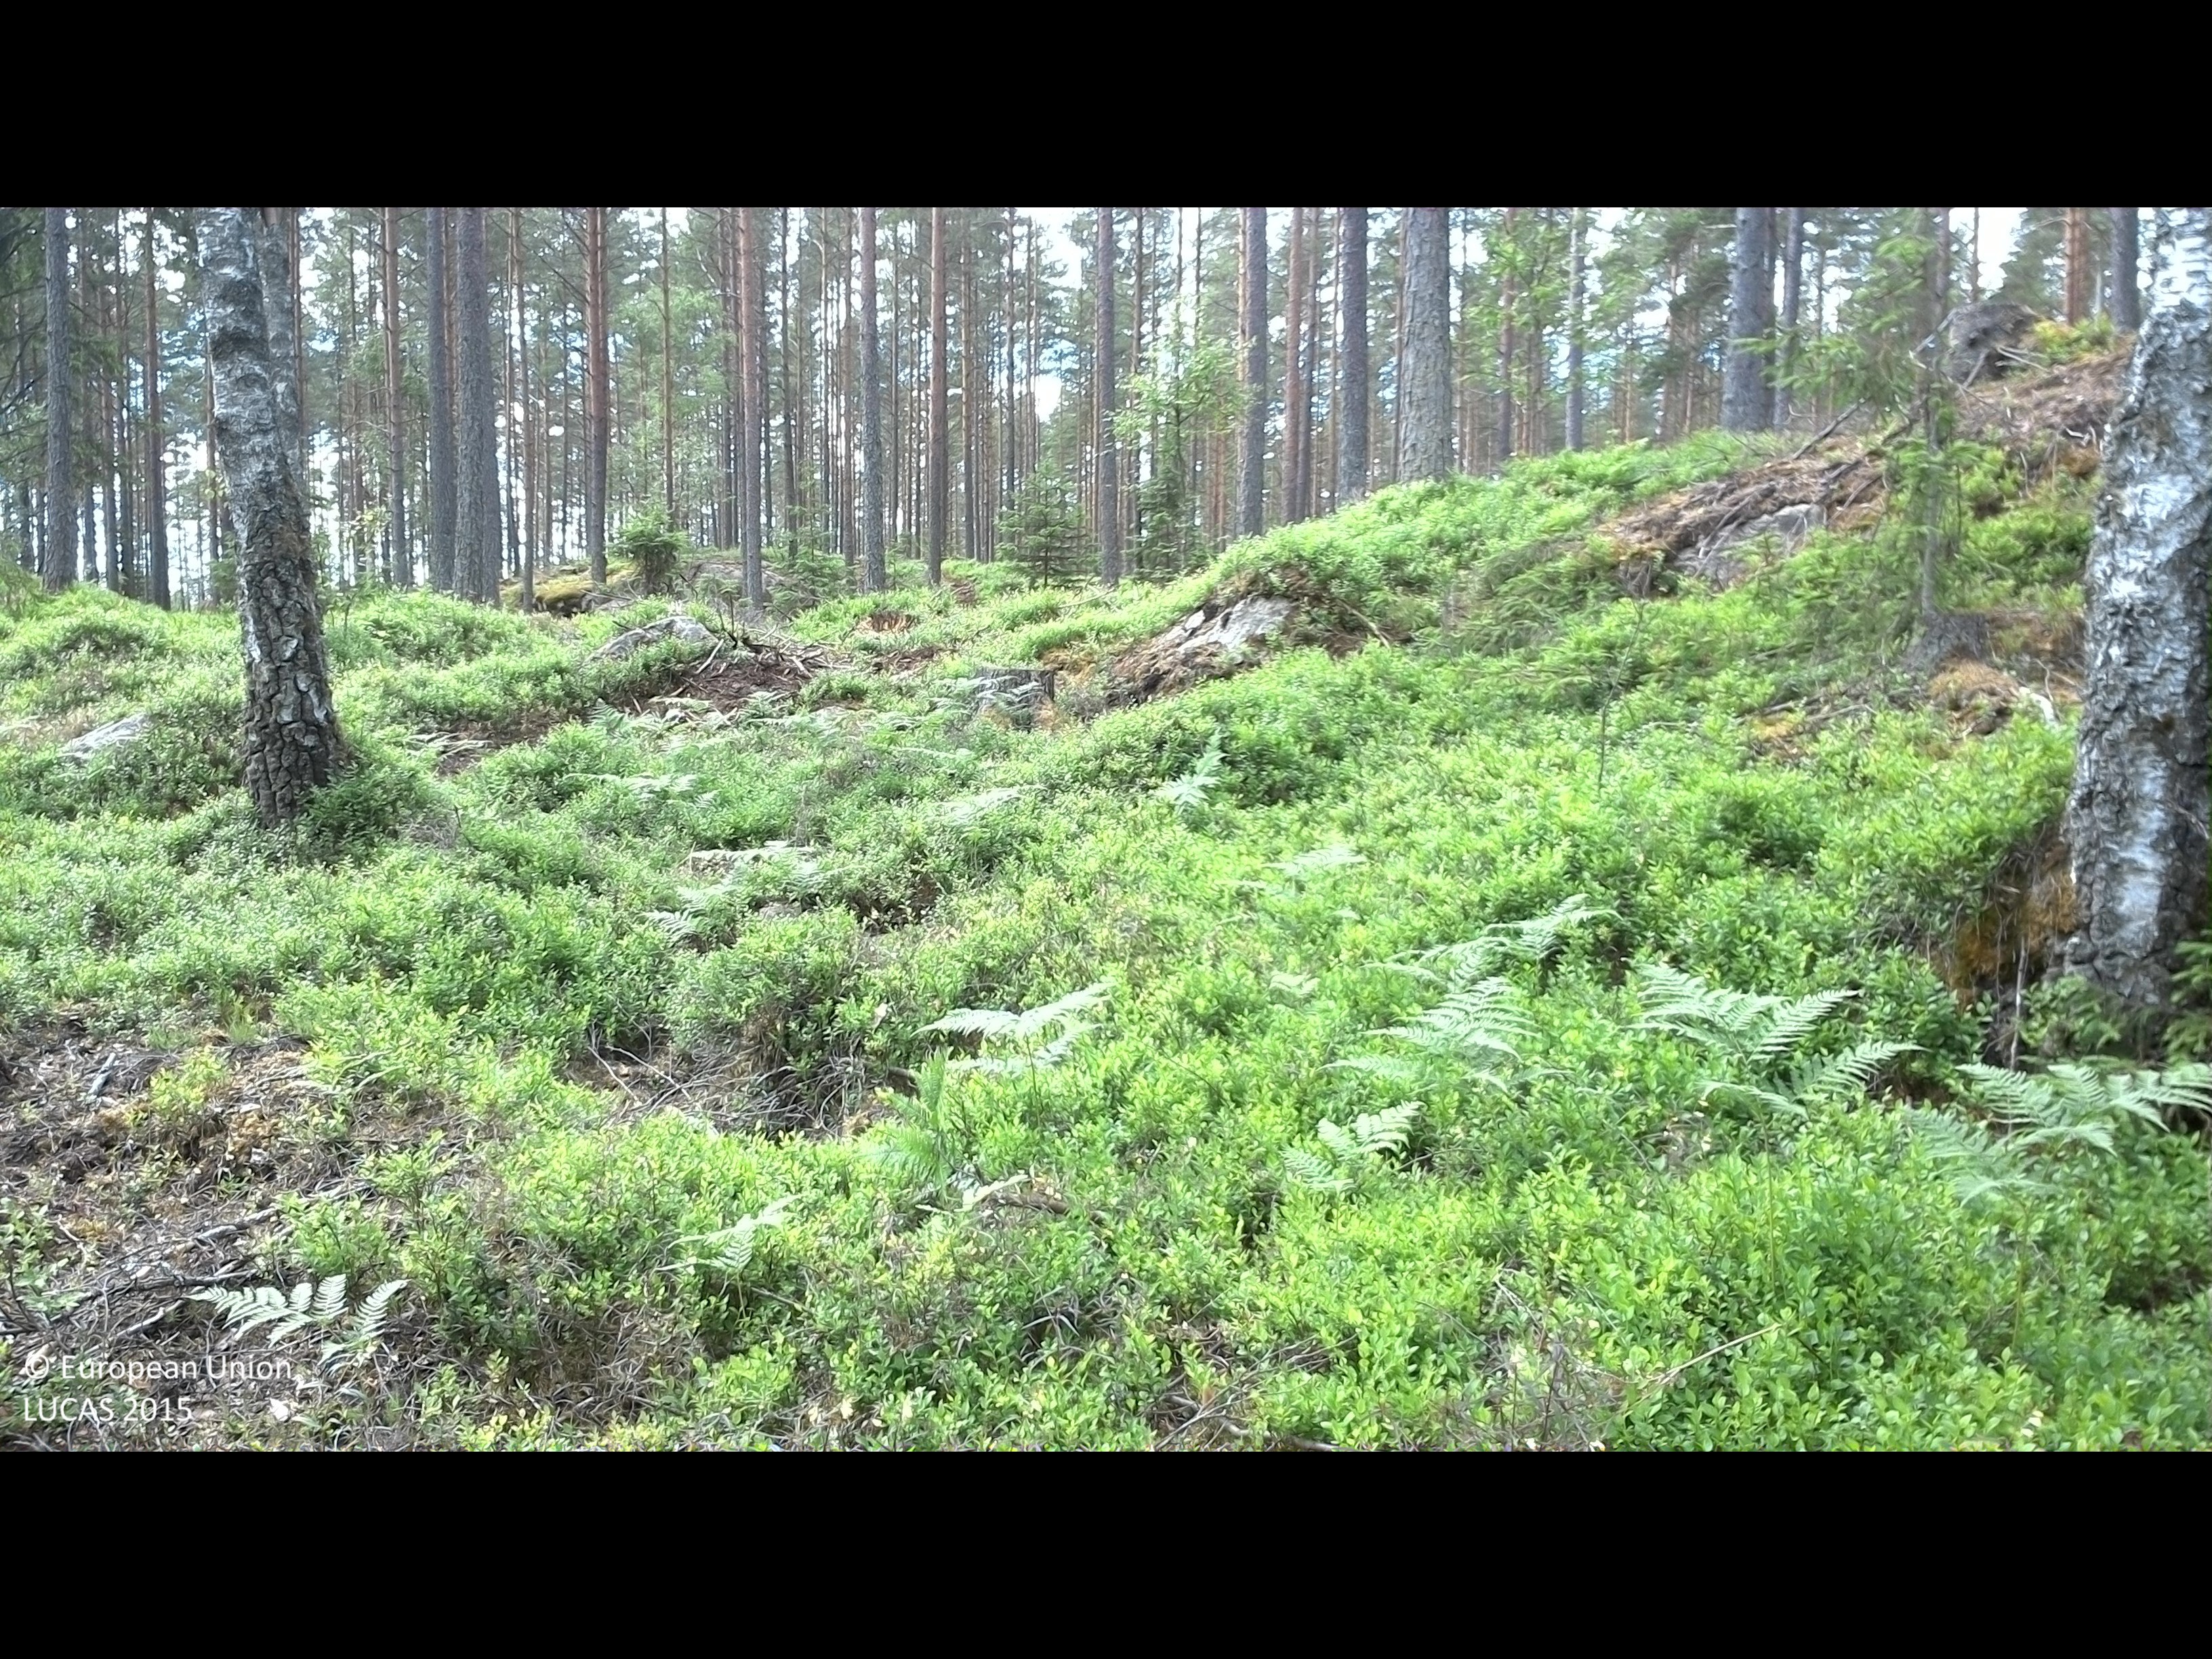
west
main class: Woodland
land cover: Pine dominated coniferous woodland
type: boreal forest
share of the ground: 50 - 75 %
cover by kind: coniferous forest trees 50 %, shrubs 40 %, broadleaved forest trees 10 %
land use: Forestry
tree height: > 5 m
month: July
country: SE
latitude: 56.4426
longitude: 15.2054
